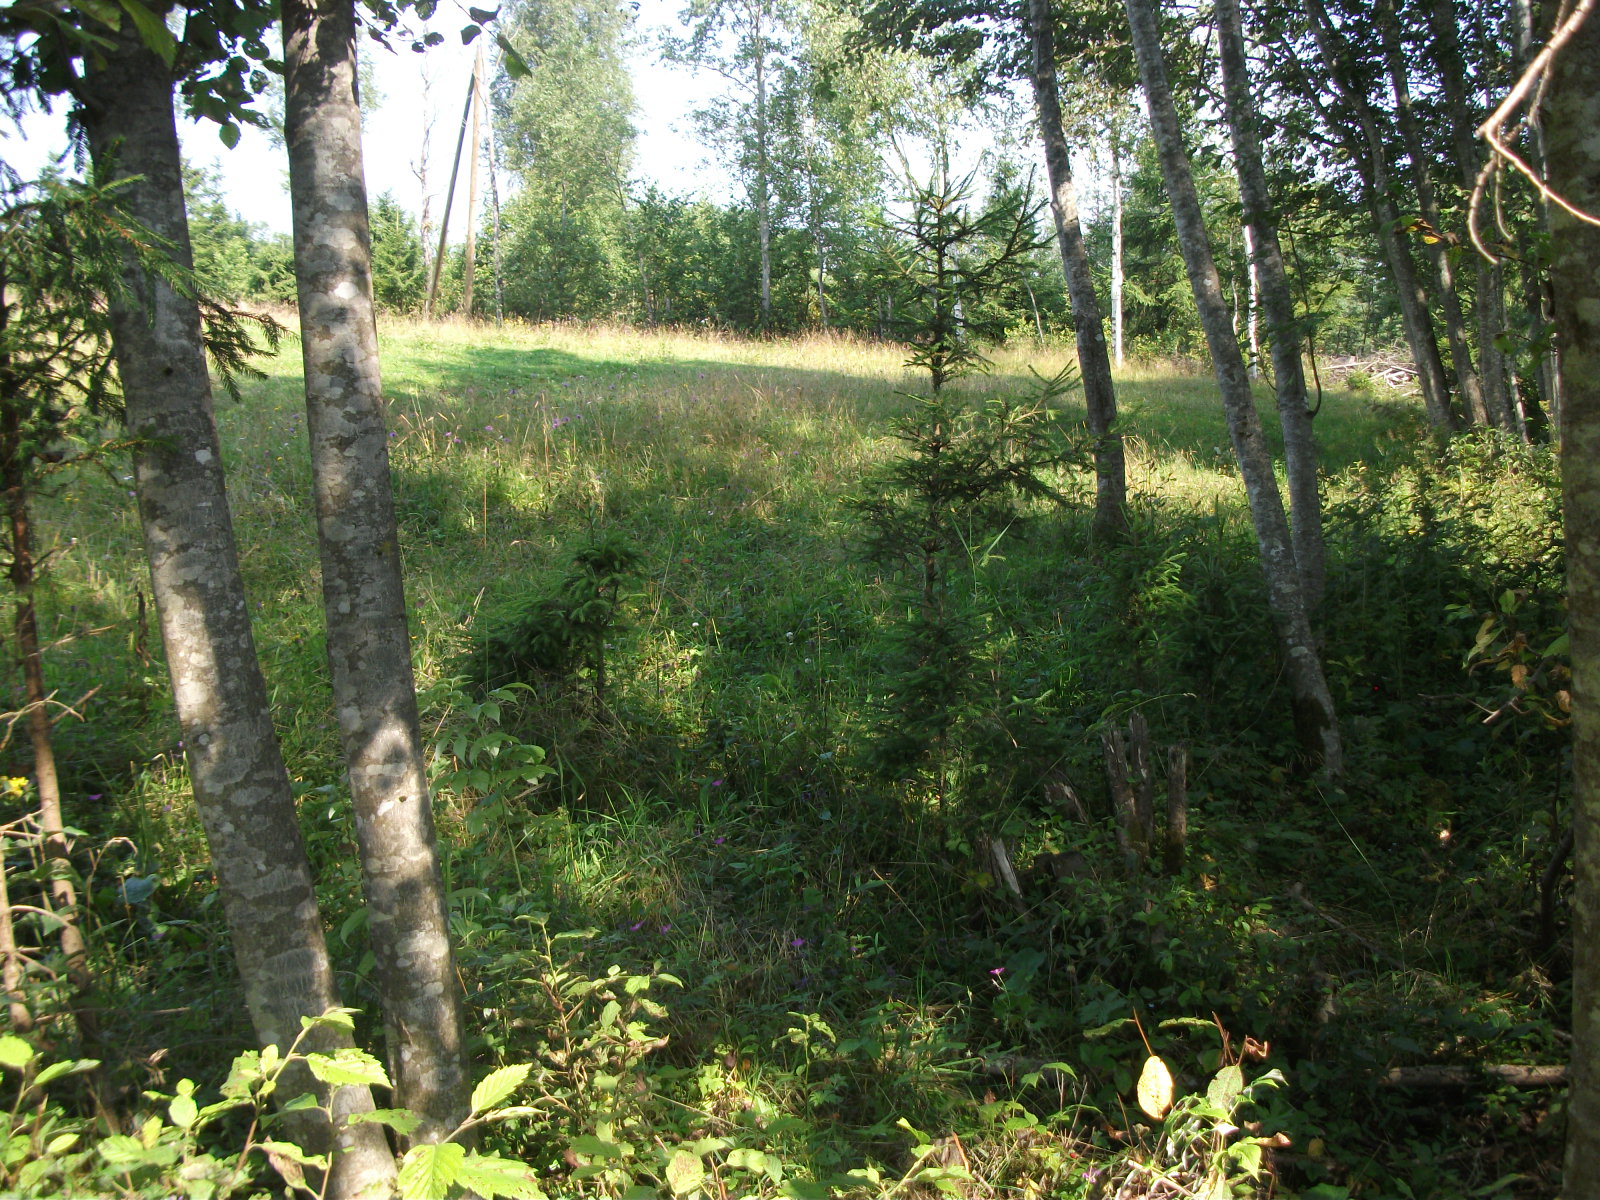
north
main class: Woodland
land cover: Broadleaved woodland
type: non-riverine alder, birch or aspen forest
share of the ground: 50 - 75 %
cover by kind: broadleaved forest trees 80 %, herbaceous plants 20 %
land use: Forestry
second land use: Agriculture (excluding fallow land and kitchen gardens)
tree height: > 5 m
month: August
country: LV
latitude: 56.8043
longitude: 25.5973
